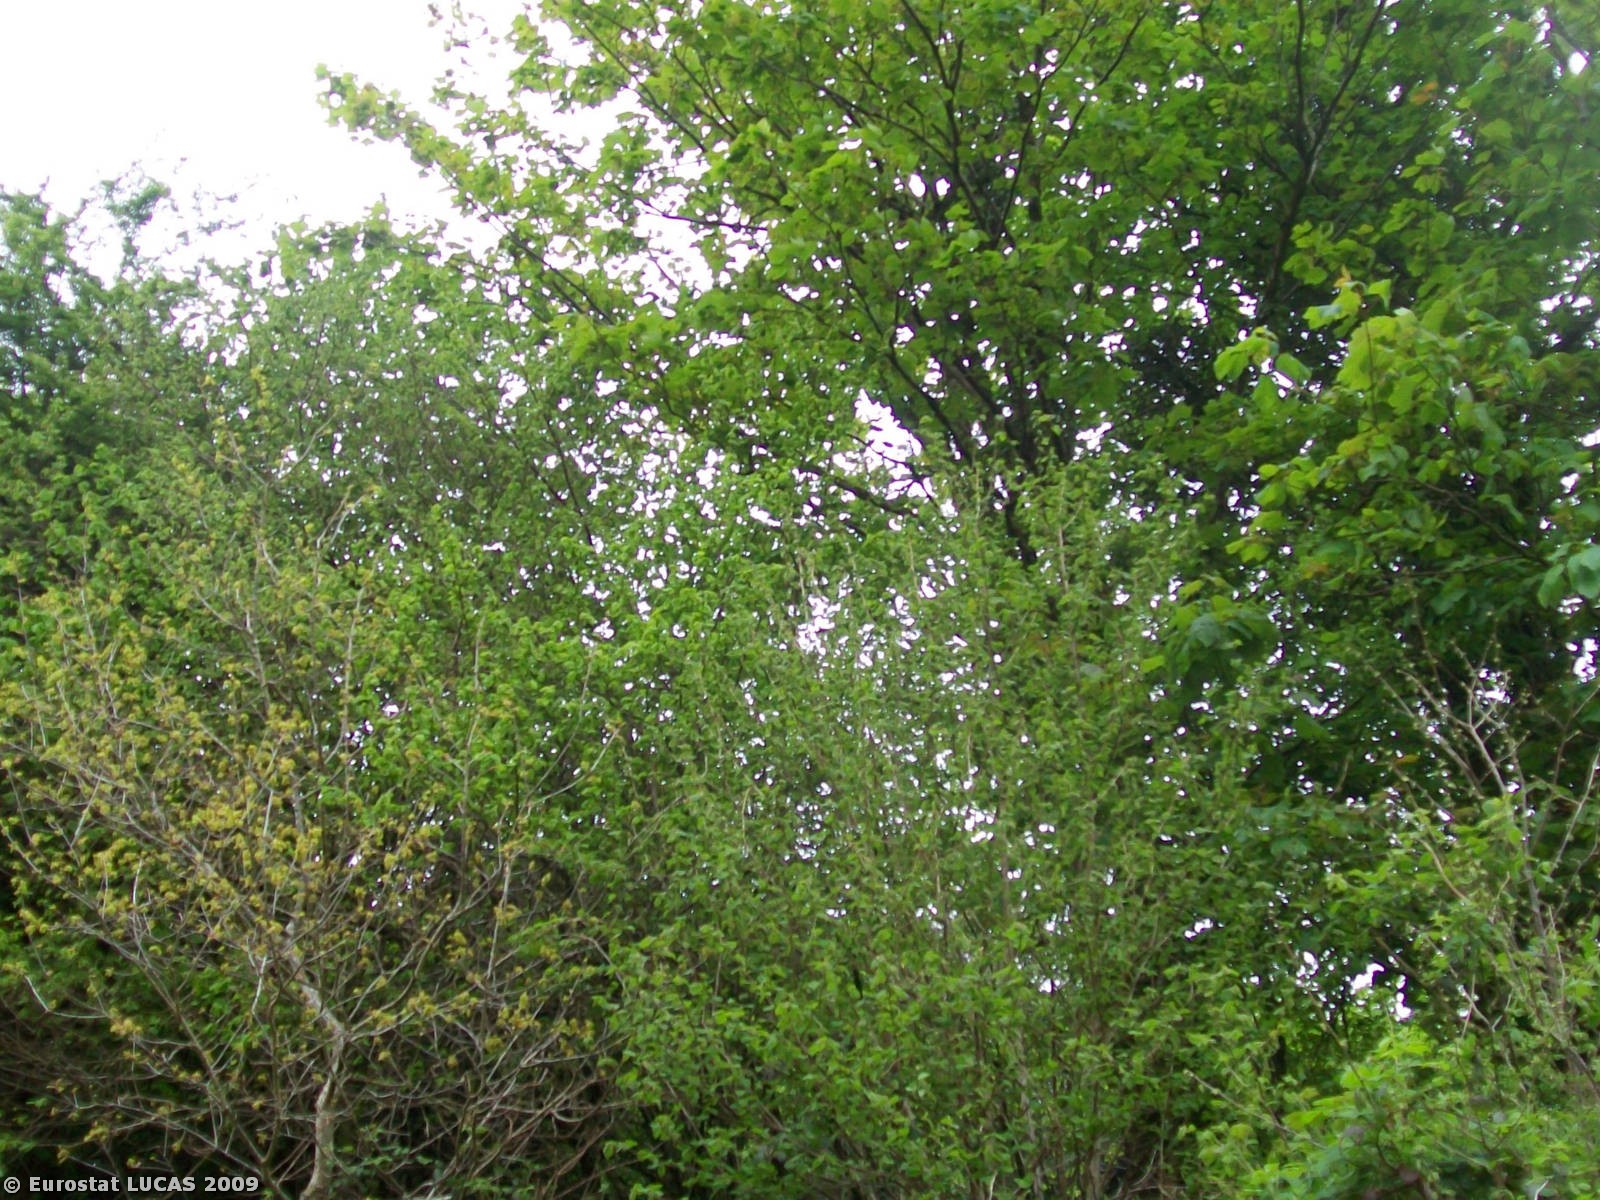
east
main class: Shrubland
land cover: Shrubland with sparse tree cover
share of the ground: > 75 %
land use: Agriculture (excluding fallow land and kitchen gardens)
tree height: > 5 m
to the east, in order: Shrubland with sparse tree cover; Abandoned hedges; Fences; Grassland with sparse tree/shrub cover; Abandoned hedges; Fences; Grassland without tree/shrub cover; Managed hedges; Grassland without tree/shrub cover
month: May
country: GB
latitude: 50.5046
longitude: -4.2695
